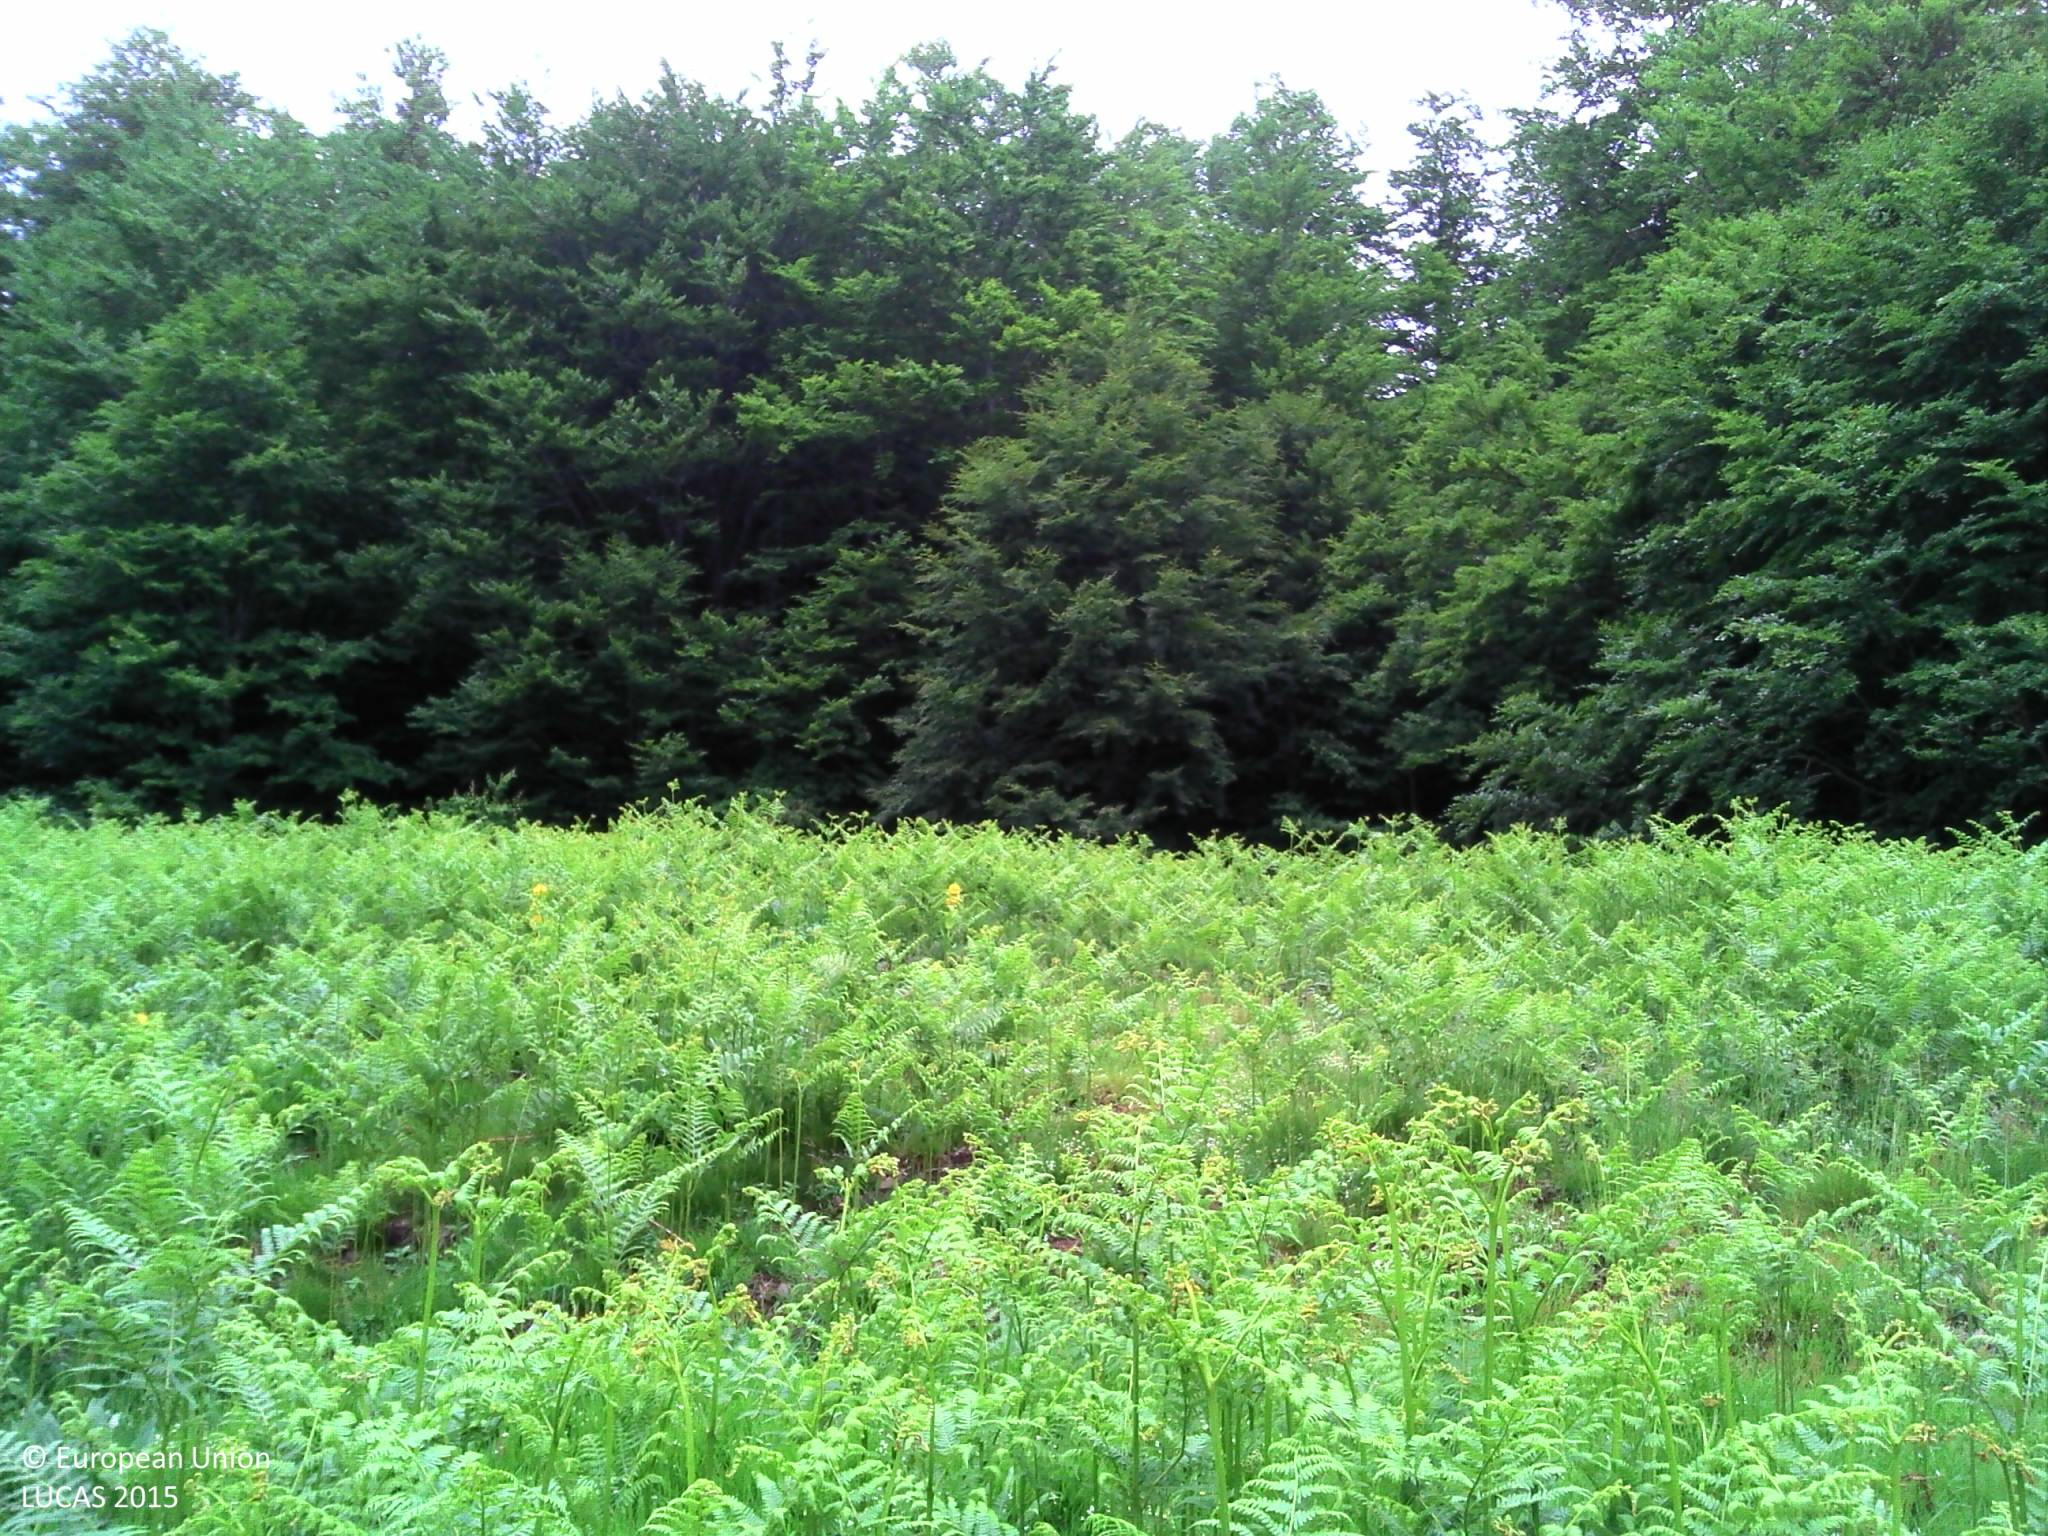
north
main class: Grassland
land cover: Grassland without tree/shrub cover
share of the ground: > 75 %
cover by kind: herbaceous plants 95 %, shrubs 5 %
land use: Agriculture (excluding fallow land and kitchen gardens)
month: June
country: FR
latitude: 42.8103
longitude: -0.5585
